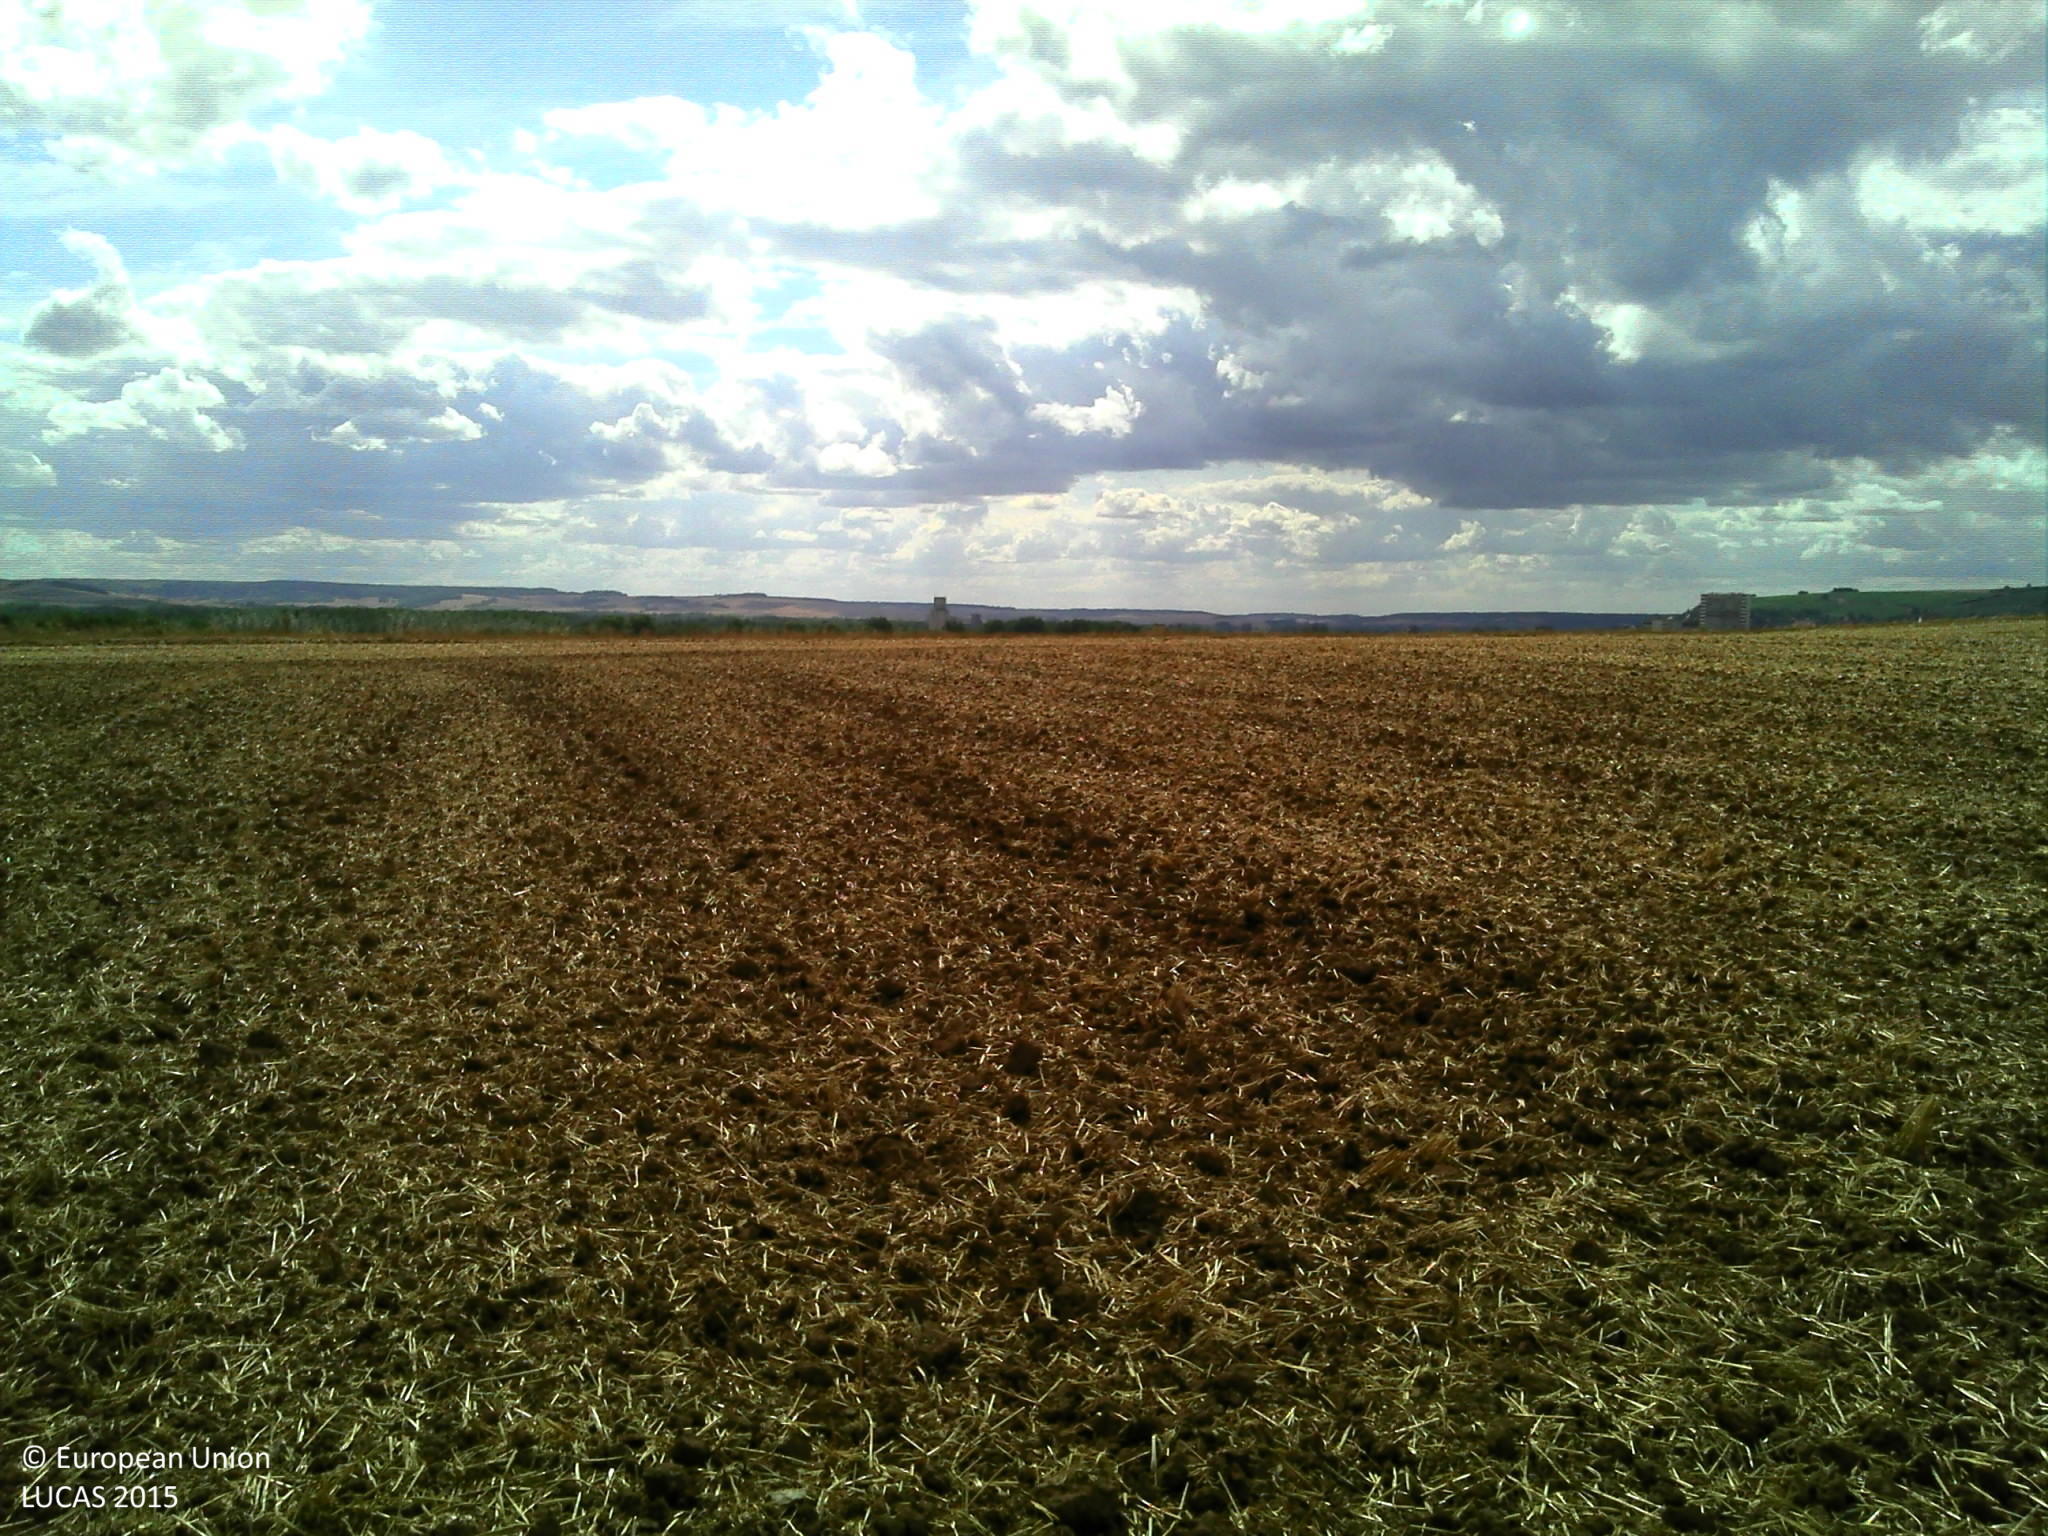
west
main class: Cropland
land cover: Common wheat
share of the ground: > 75 %
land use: Agriculture (excluding fallow land and kitchen gardens)
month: July
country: FR
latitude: 47.9742
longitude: 3.4442
